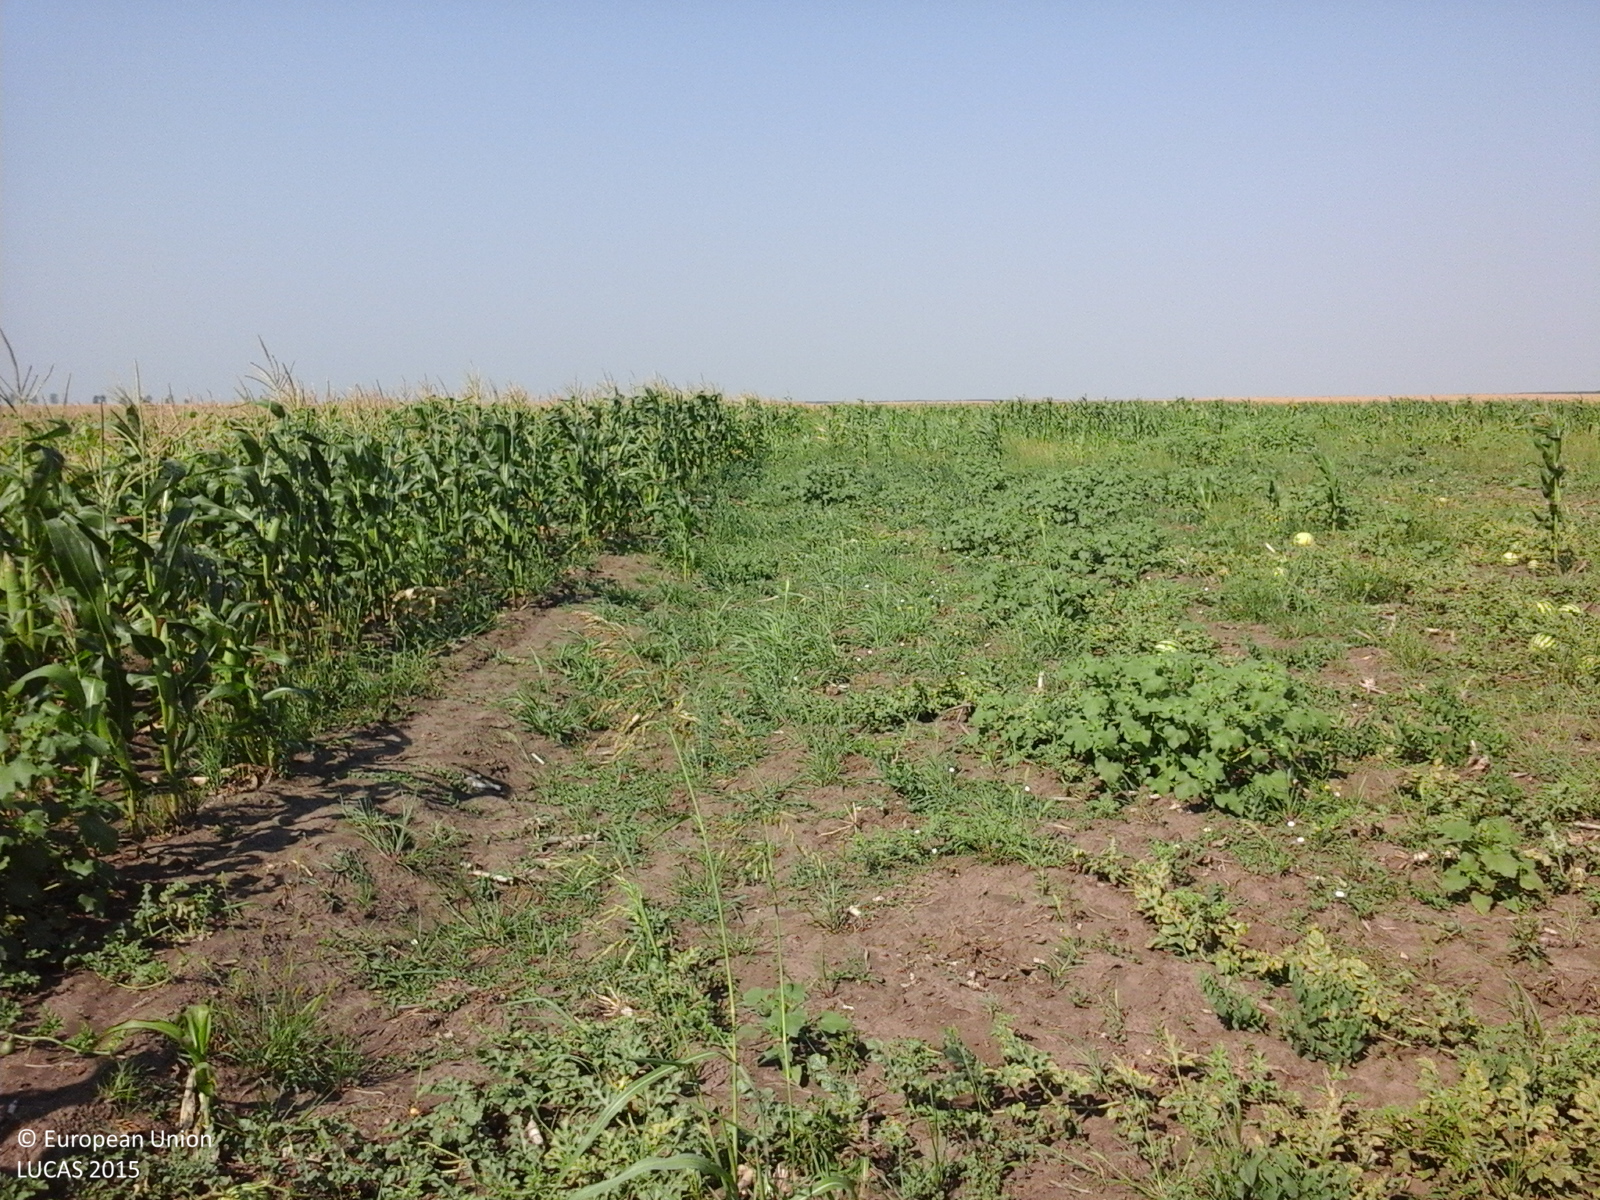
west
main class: Cropland
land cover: Maize
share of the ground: > 75 %
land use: Agriculture (excluding fallow land and kitchen gardens)
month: August
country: RO
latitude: 45.8430
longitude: 27.6603
